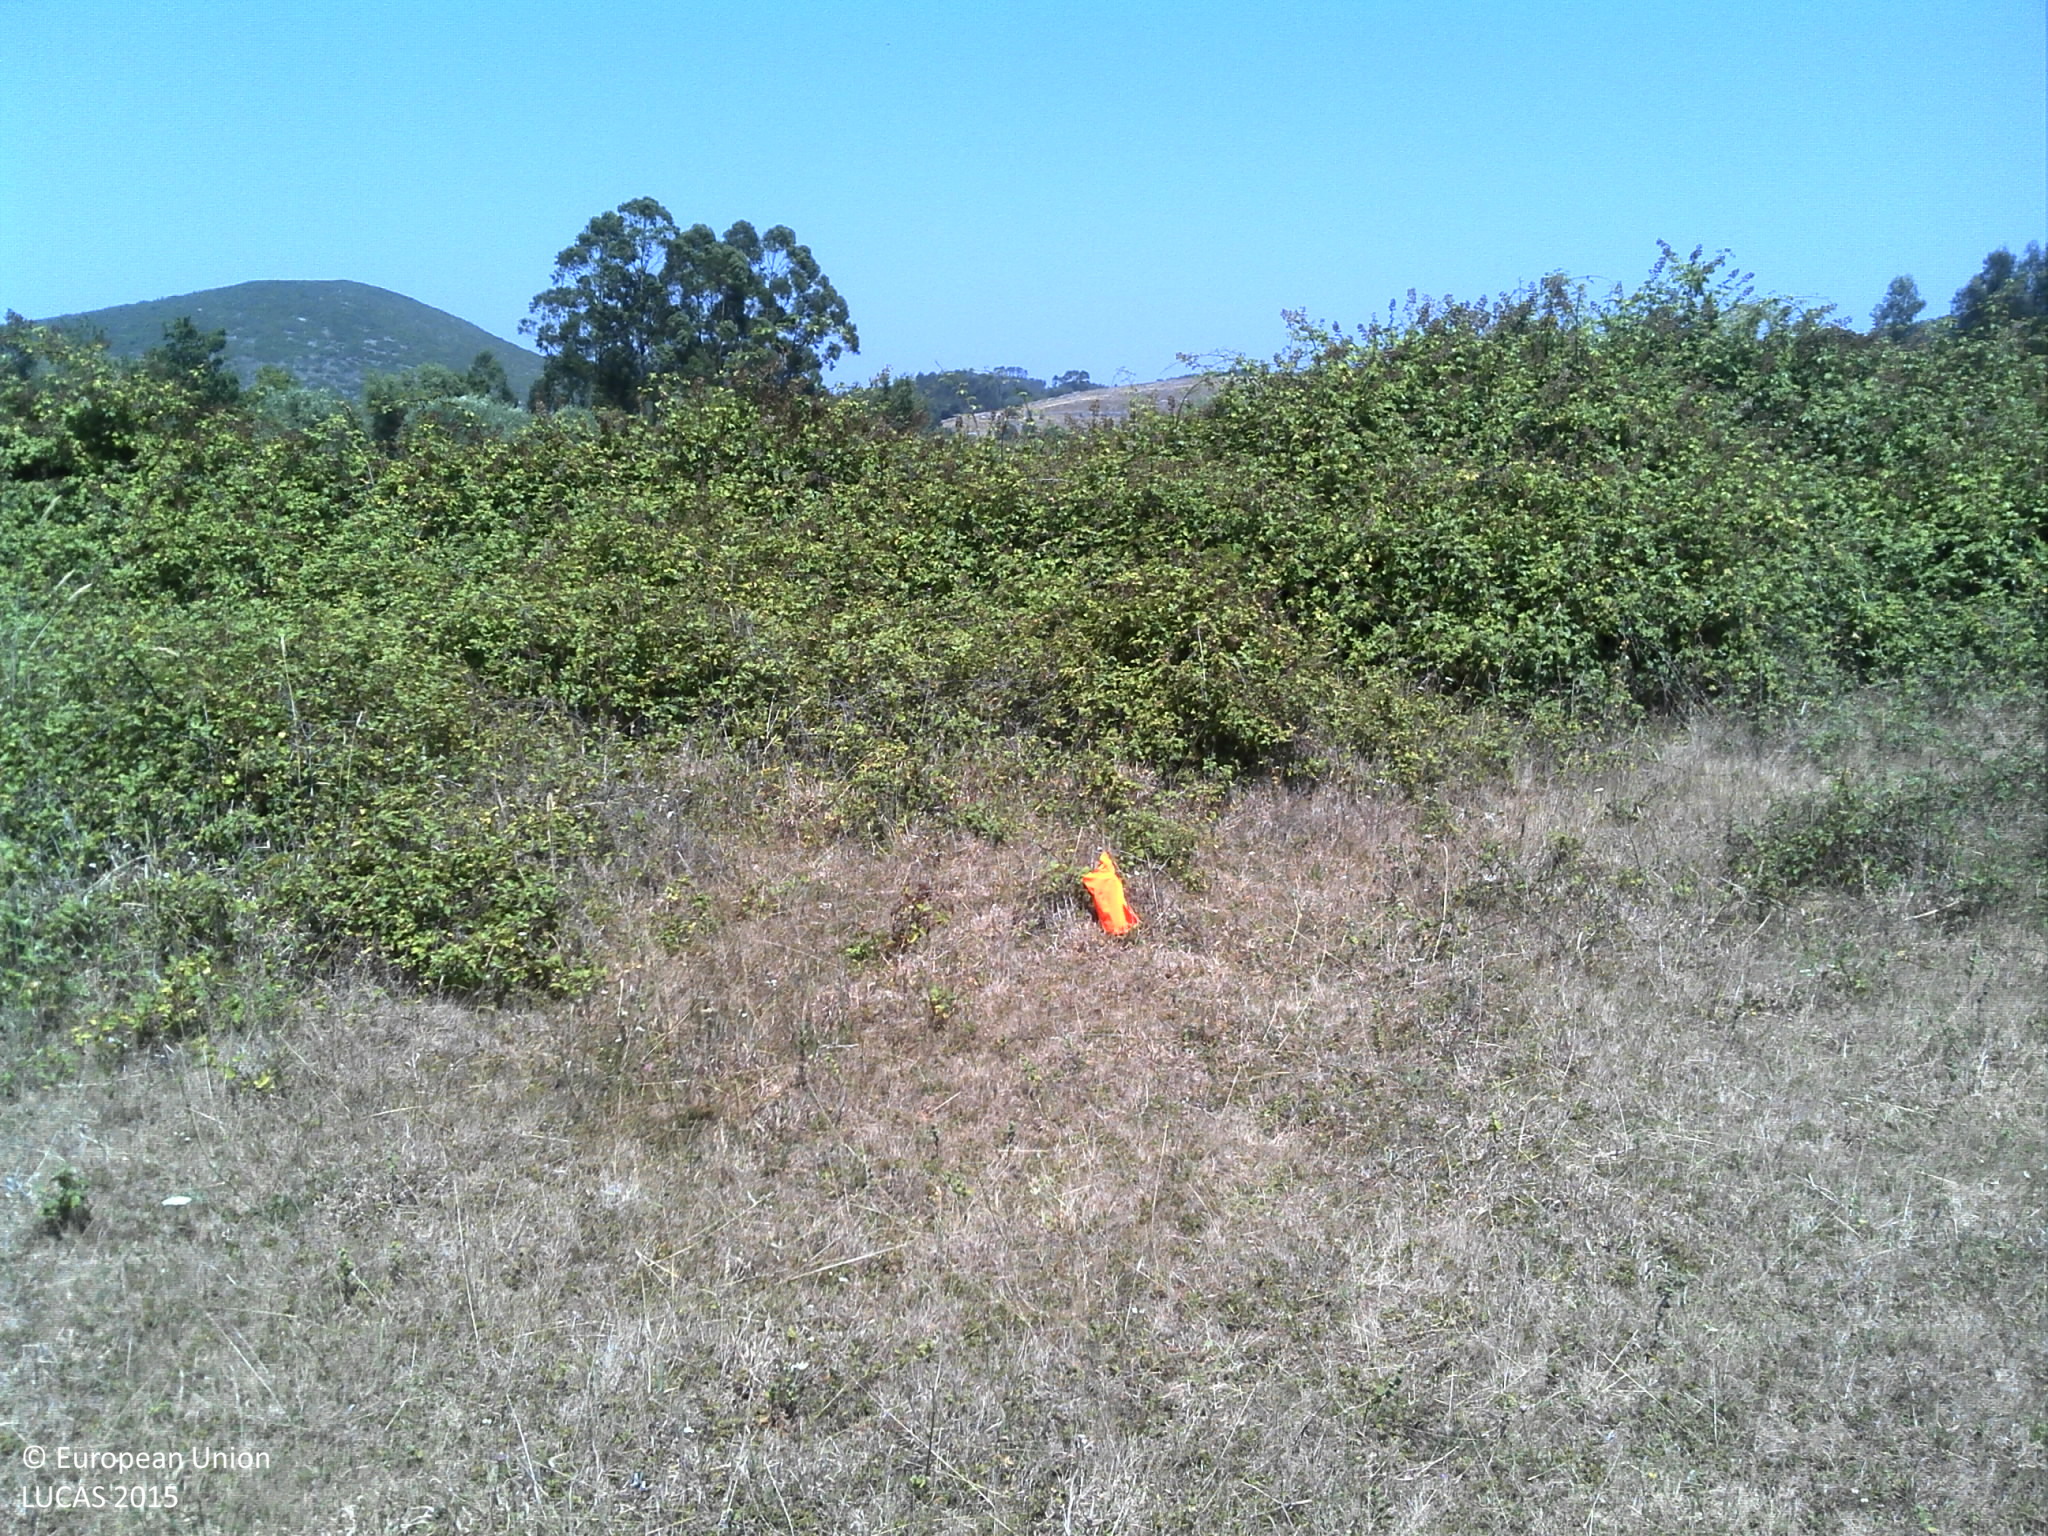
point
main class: Grassland
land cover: Grassland with sparse tree/shrub cover
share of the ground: > 75 %
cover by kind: herbaceous plants 80 %, shrubs 10 %, broadleaved forest trees 5 %, unconsolidated bare surface 5 %
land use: Abandoned areas
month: July
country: PT
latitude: 40.0628
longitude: -8.5014
